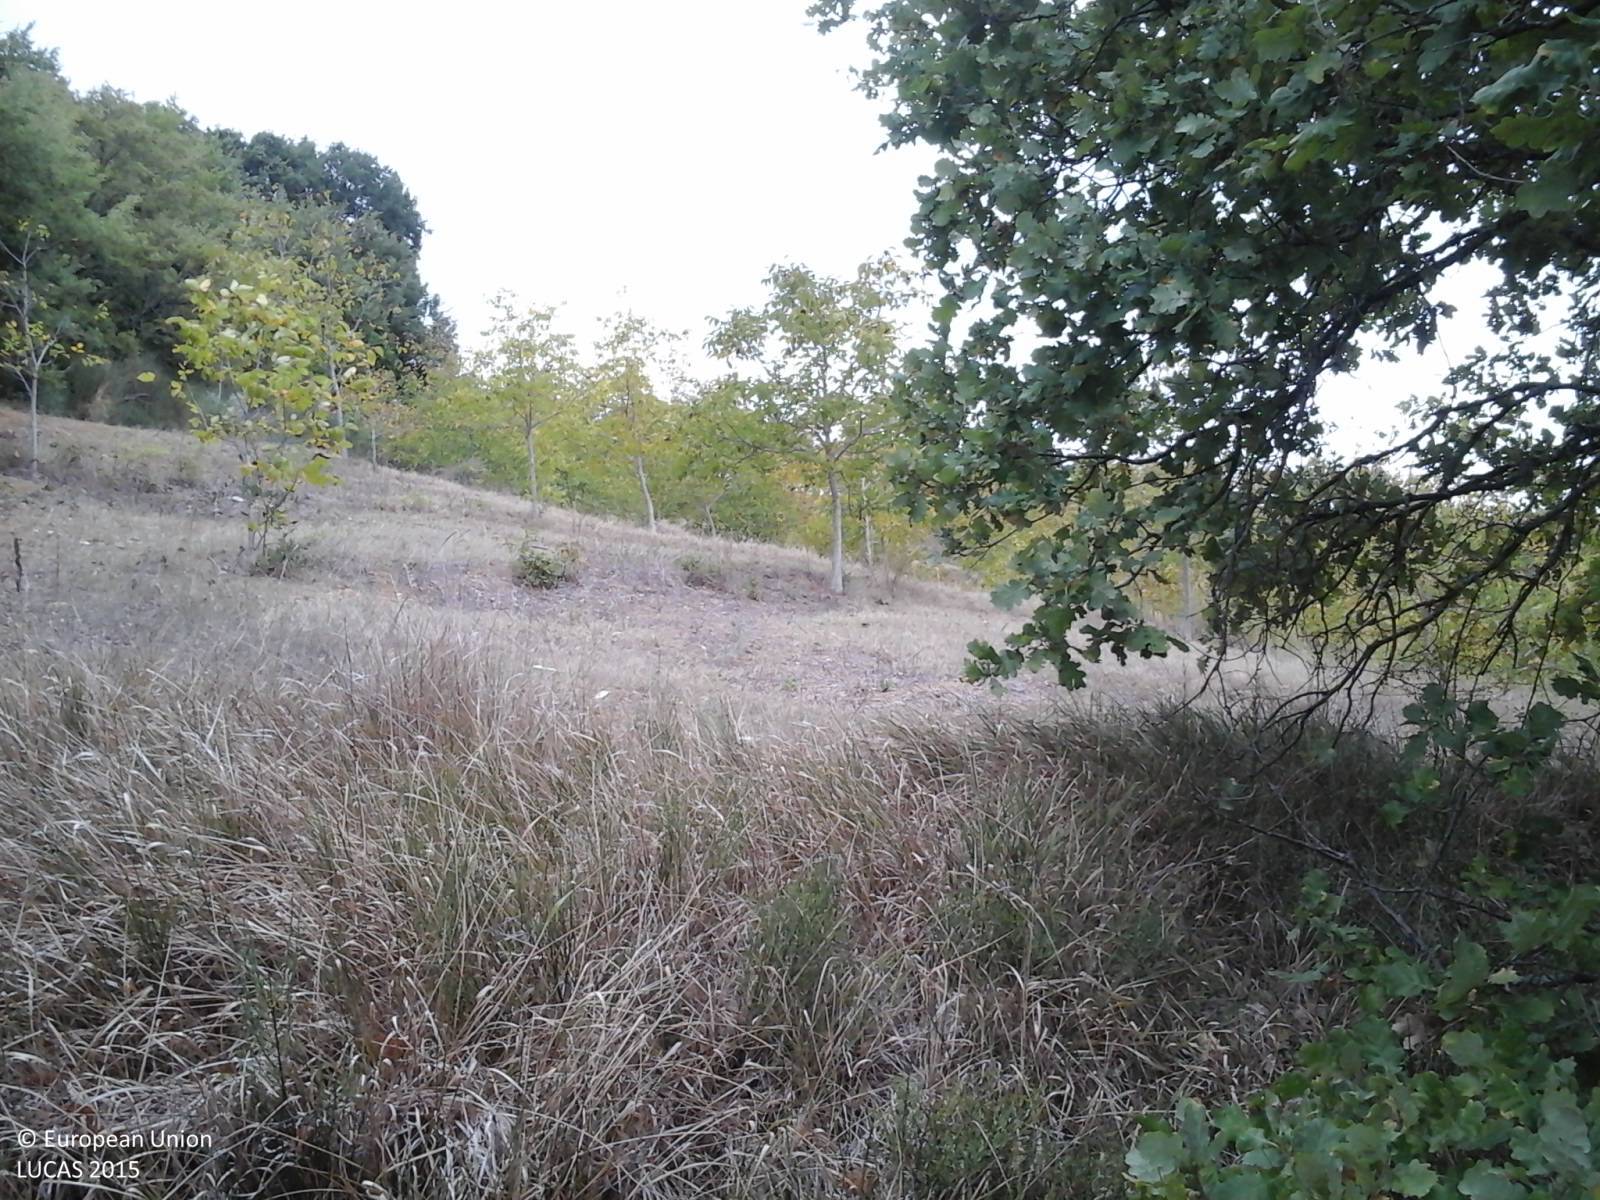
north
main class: Woodland
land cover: Broadleaved woodland
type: thermophilous deciduous forest
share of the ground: > 75 %
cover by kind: broadleaved forest trees 100 %
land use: Forestry
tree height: > 5 m
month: September
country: IT
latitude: 42.9365
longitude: 12.2357
